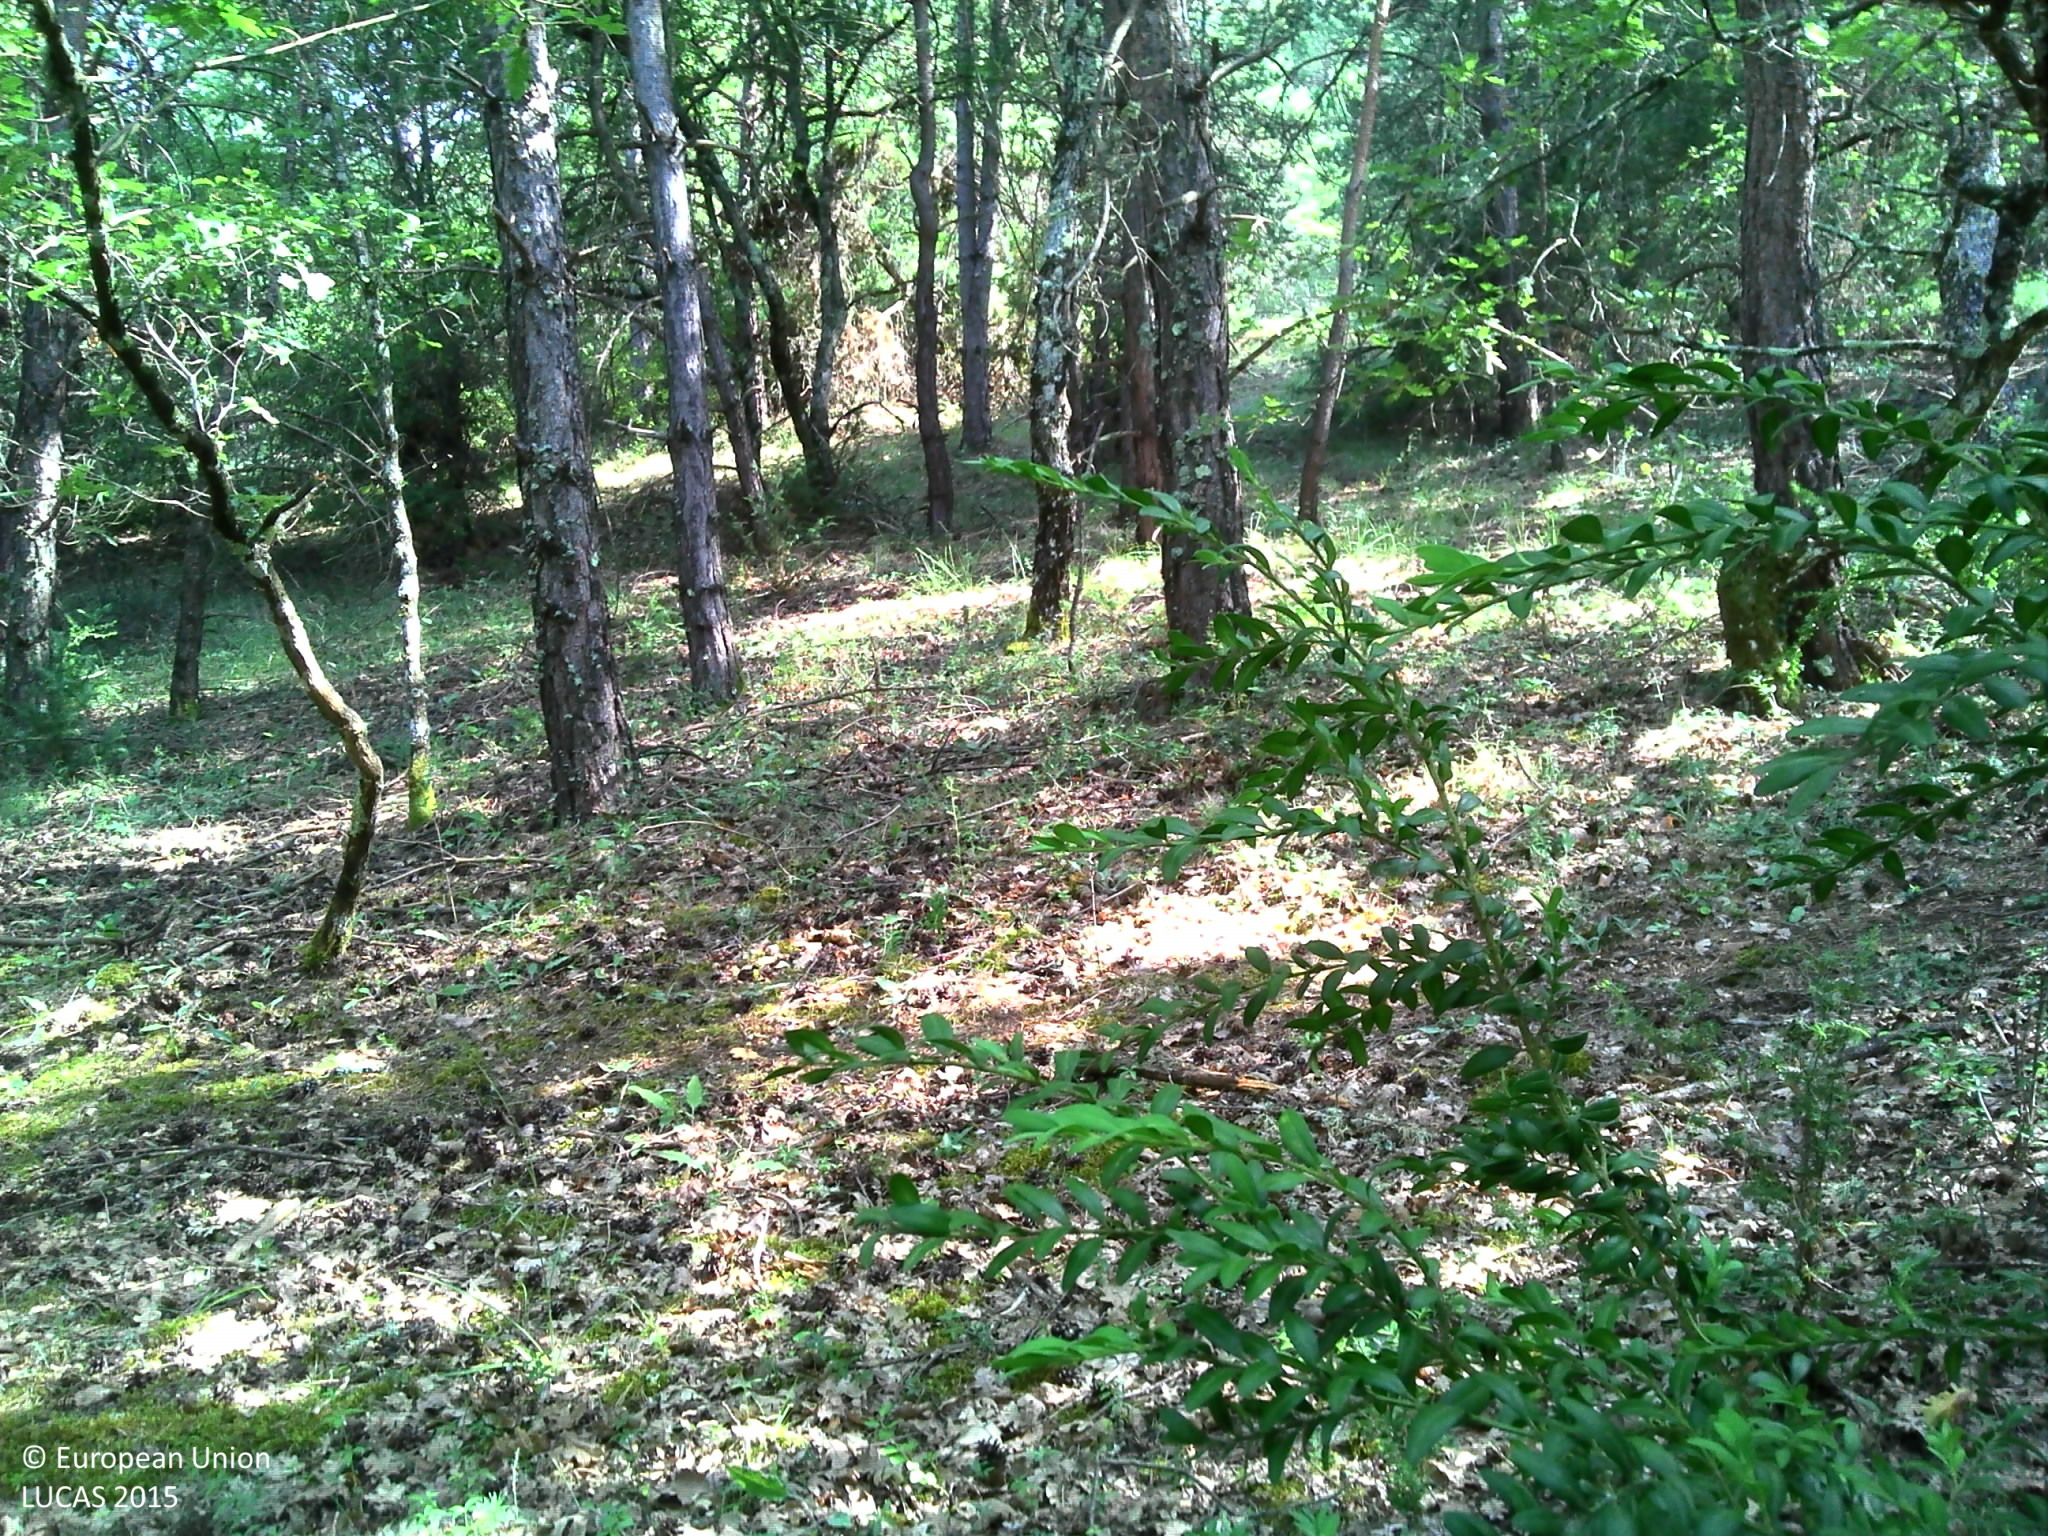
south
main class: Woodland
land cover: Pine dominated mixed woodland
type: coniferous forest of the mediterranean region
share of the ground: > 75 %
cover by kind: coniferous forest trees 40 %, broadleaved forest trees 40 %, shrubs 15 %, herbaceous plants 5 %
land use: Semi-natural and natural areas not in use
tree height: > 5 m
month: July
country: FR
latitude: 43.8426
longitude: 5.6180
